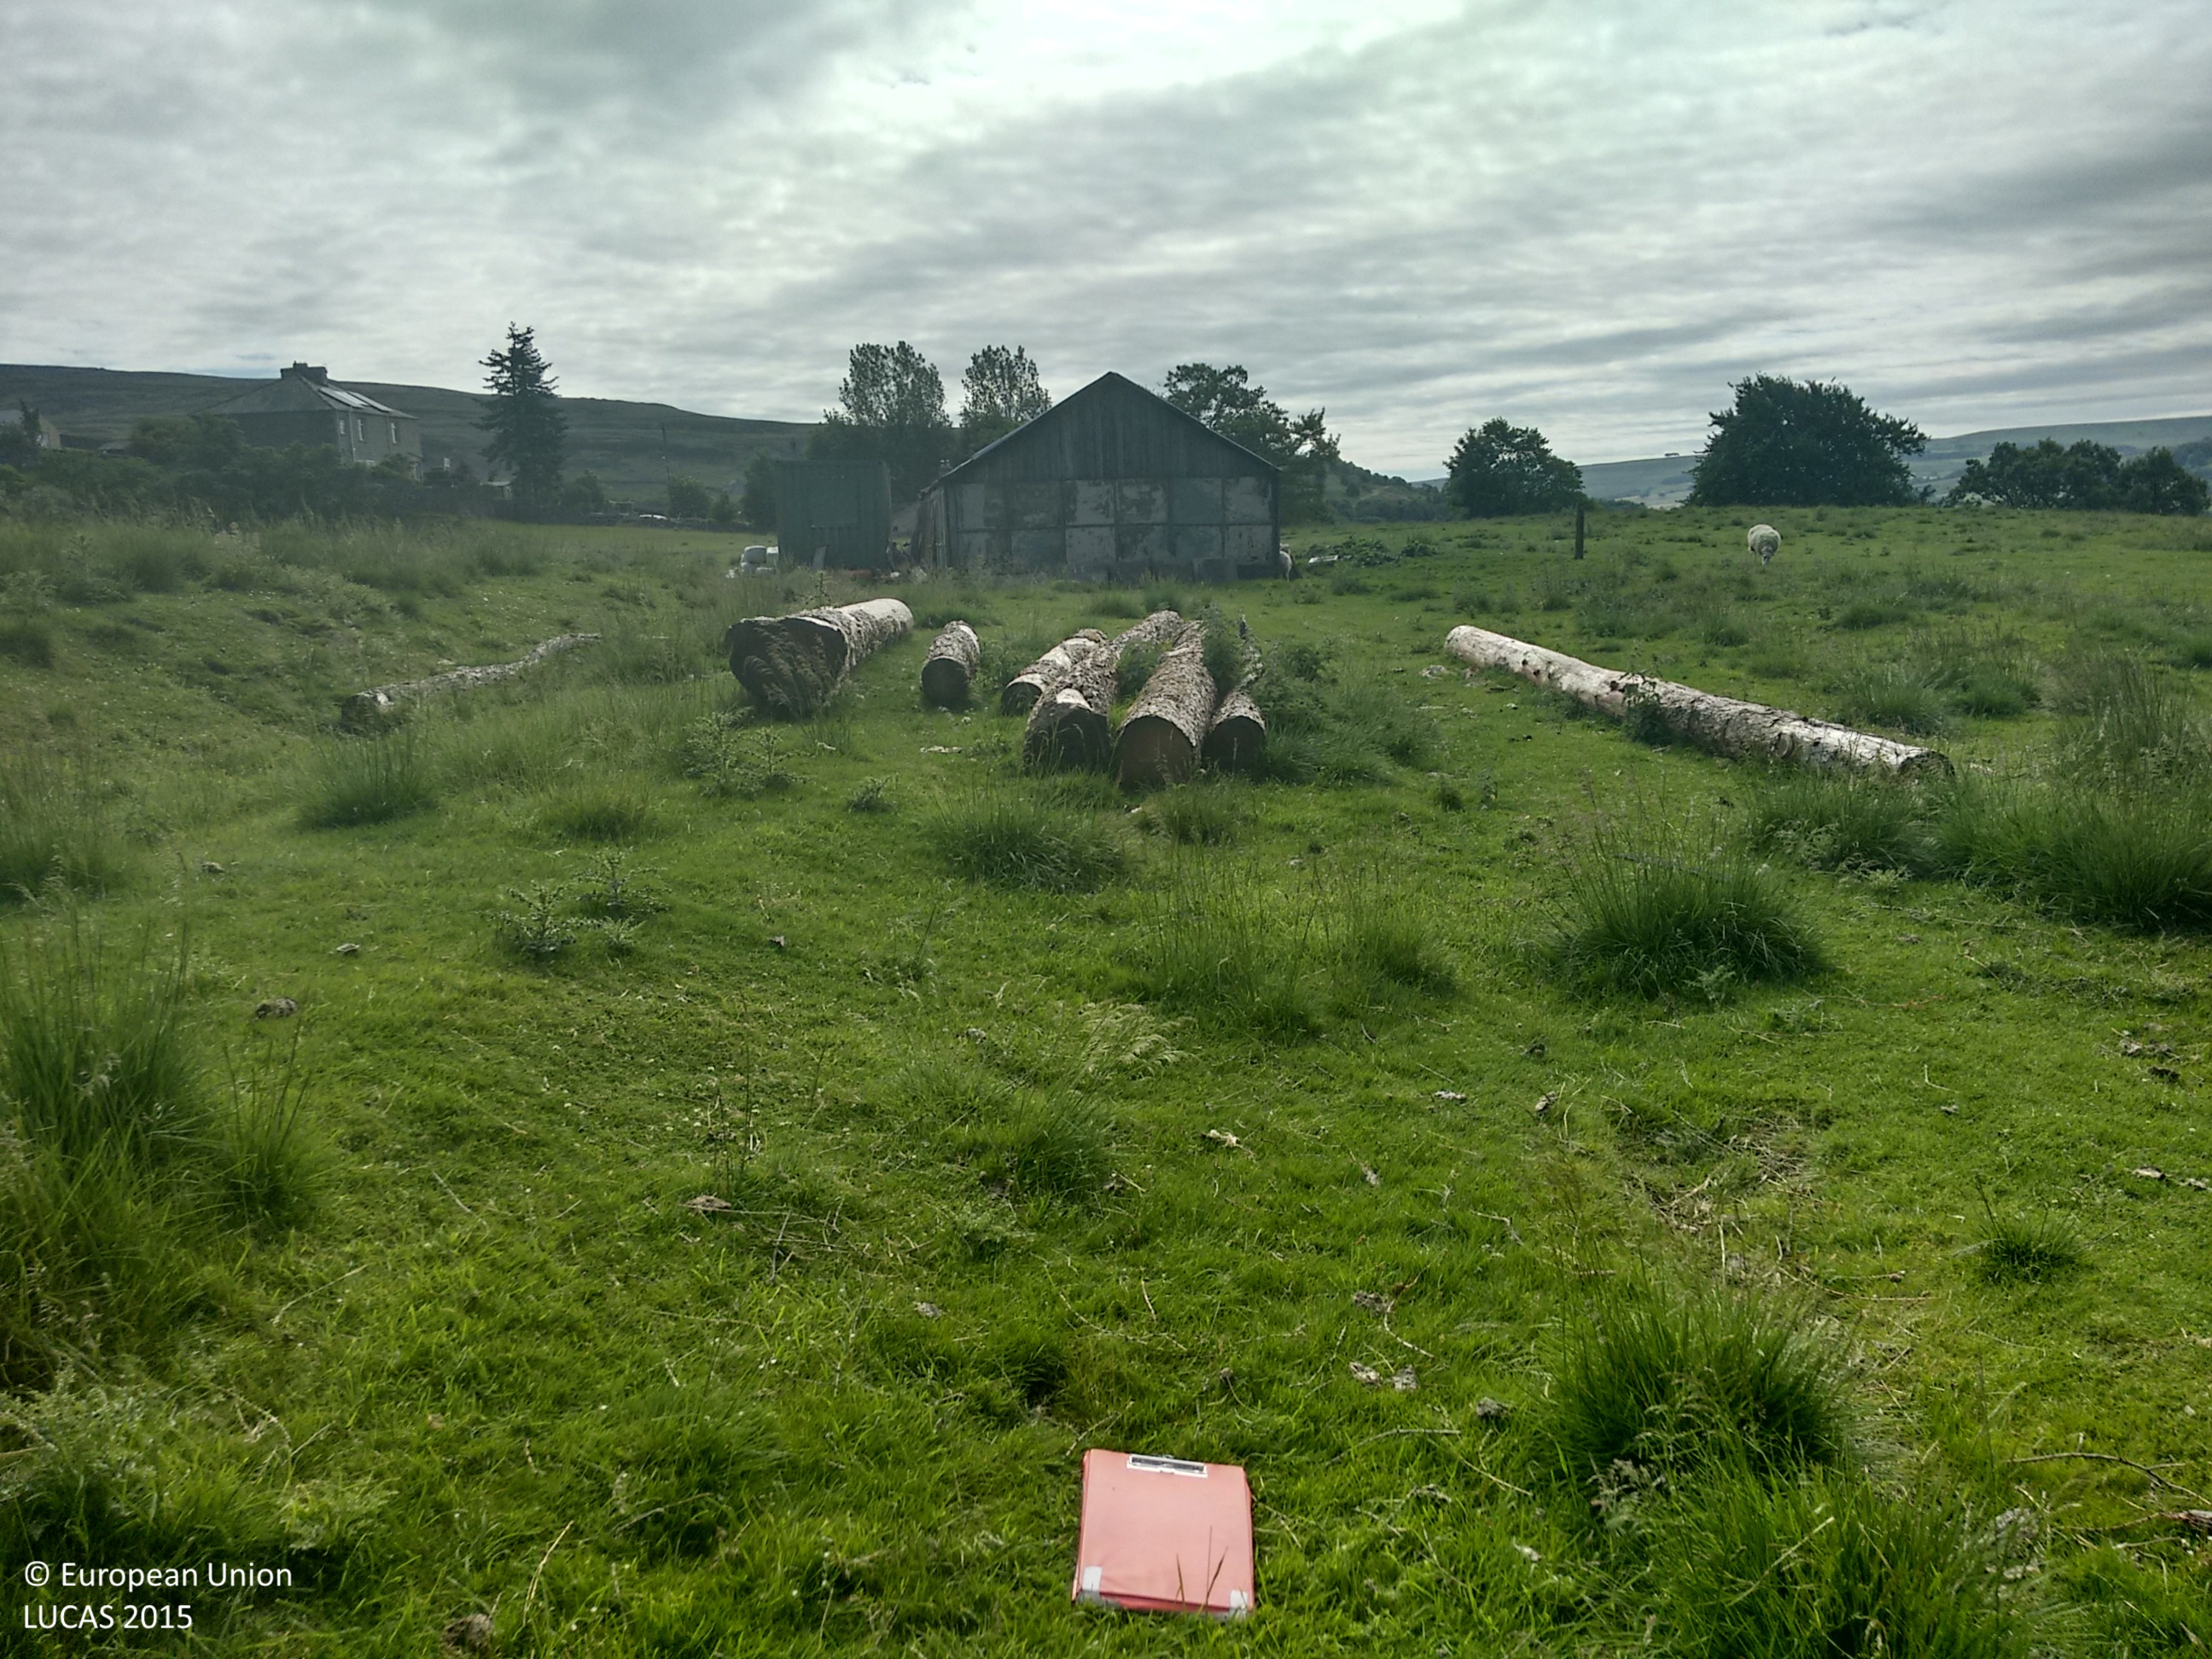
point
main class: Grassland
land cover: Grassland without tree/shrub cover
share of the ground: > 75 %
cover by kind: herbaceous plants 100 %
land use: Agriculture (excluding fallow land and kitchen gardens)
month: June
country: GB
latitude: 54.7486
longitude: -2.0023
